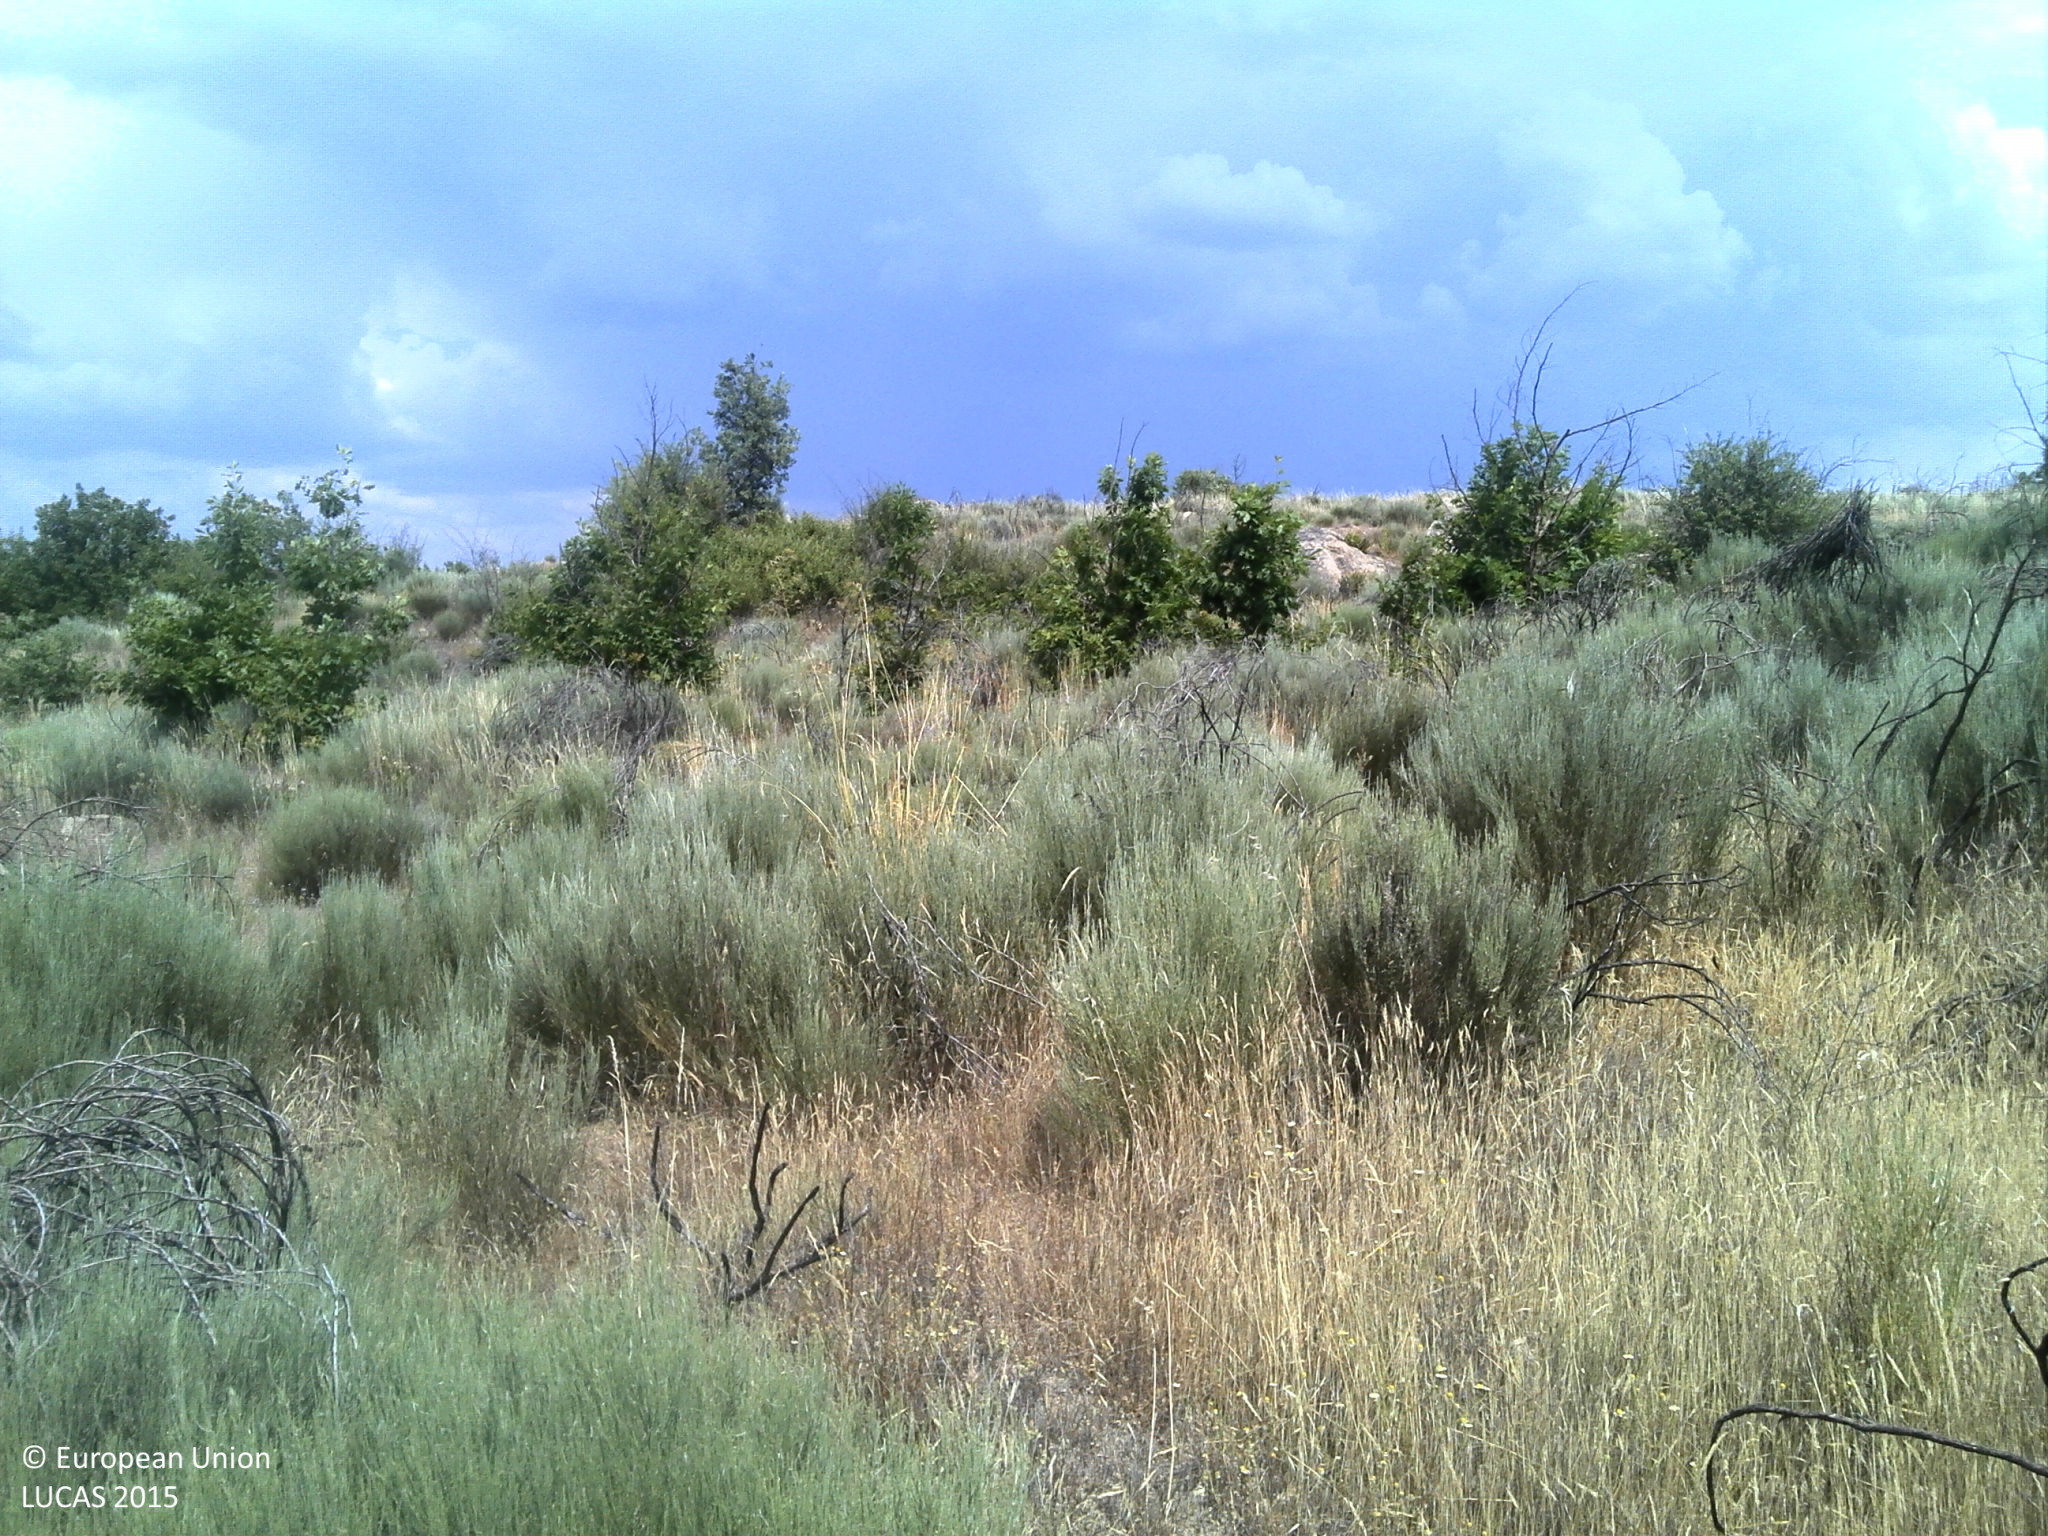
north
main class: Shrubland
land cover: Shrubland without tree cover
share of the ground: 50 - 75 %
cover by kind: shrubs 60 %, herbaceous plants 30 %, unconsolidated bare surface 5 %
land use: Abandoned areas
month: June
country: PT
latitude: 40.3011
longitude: -7.3154
